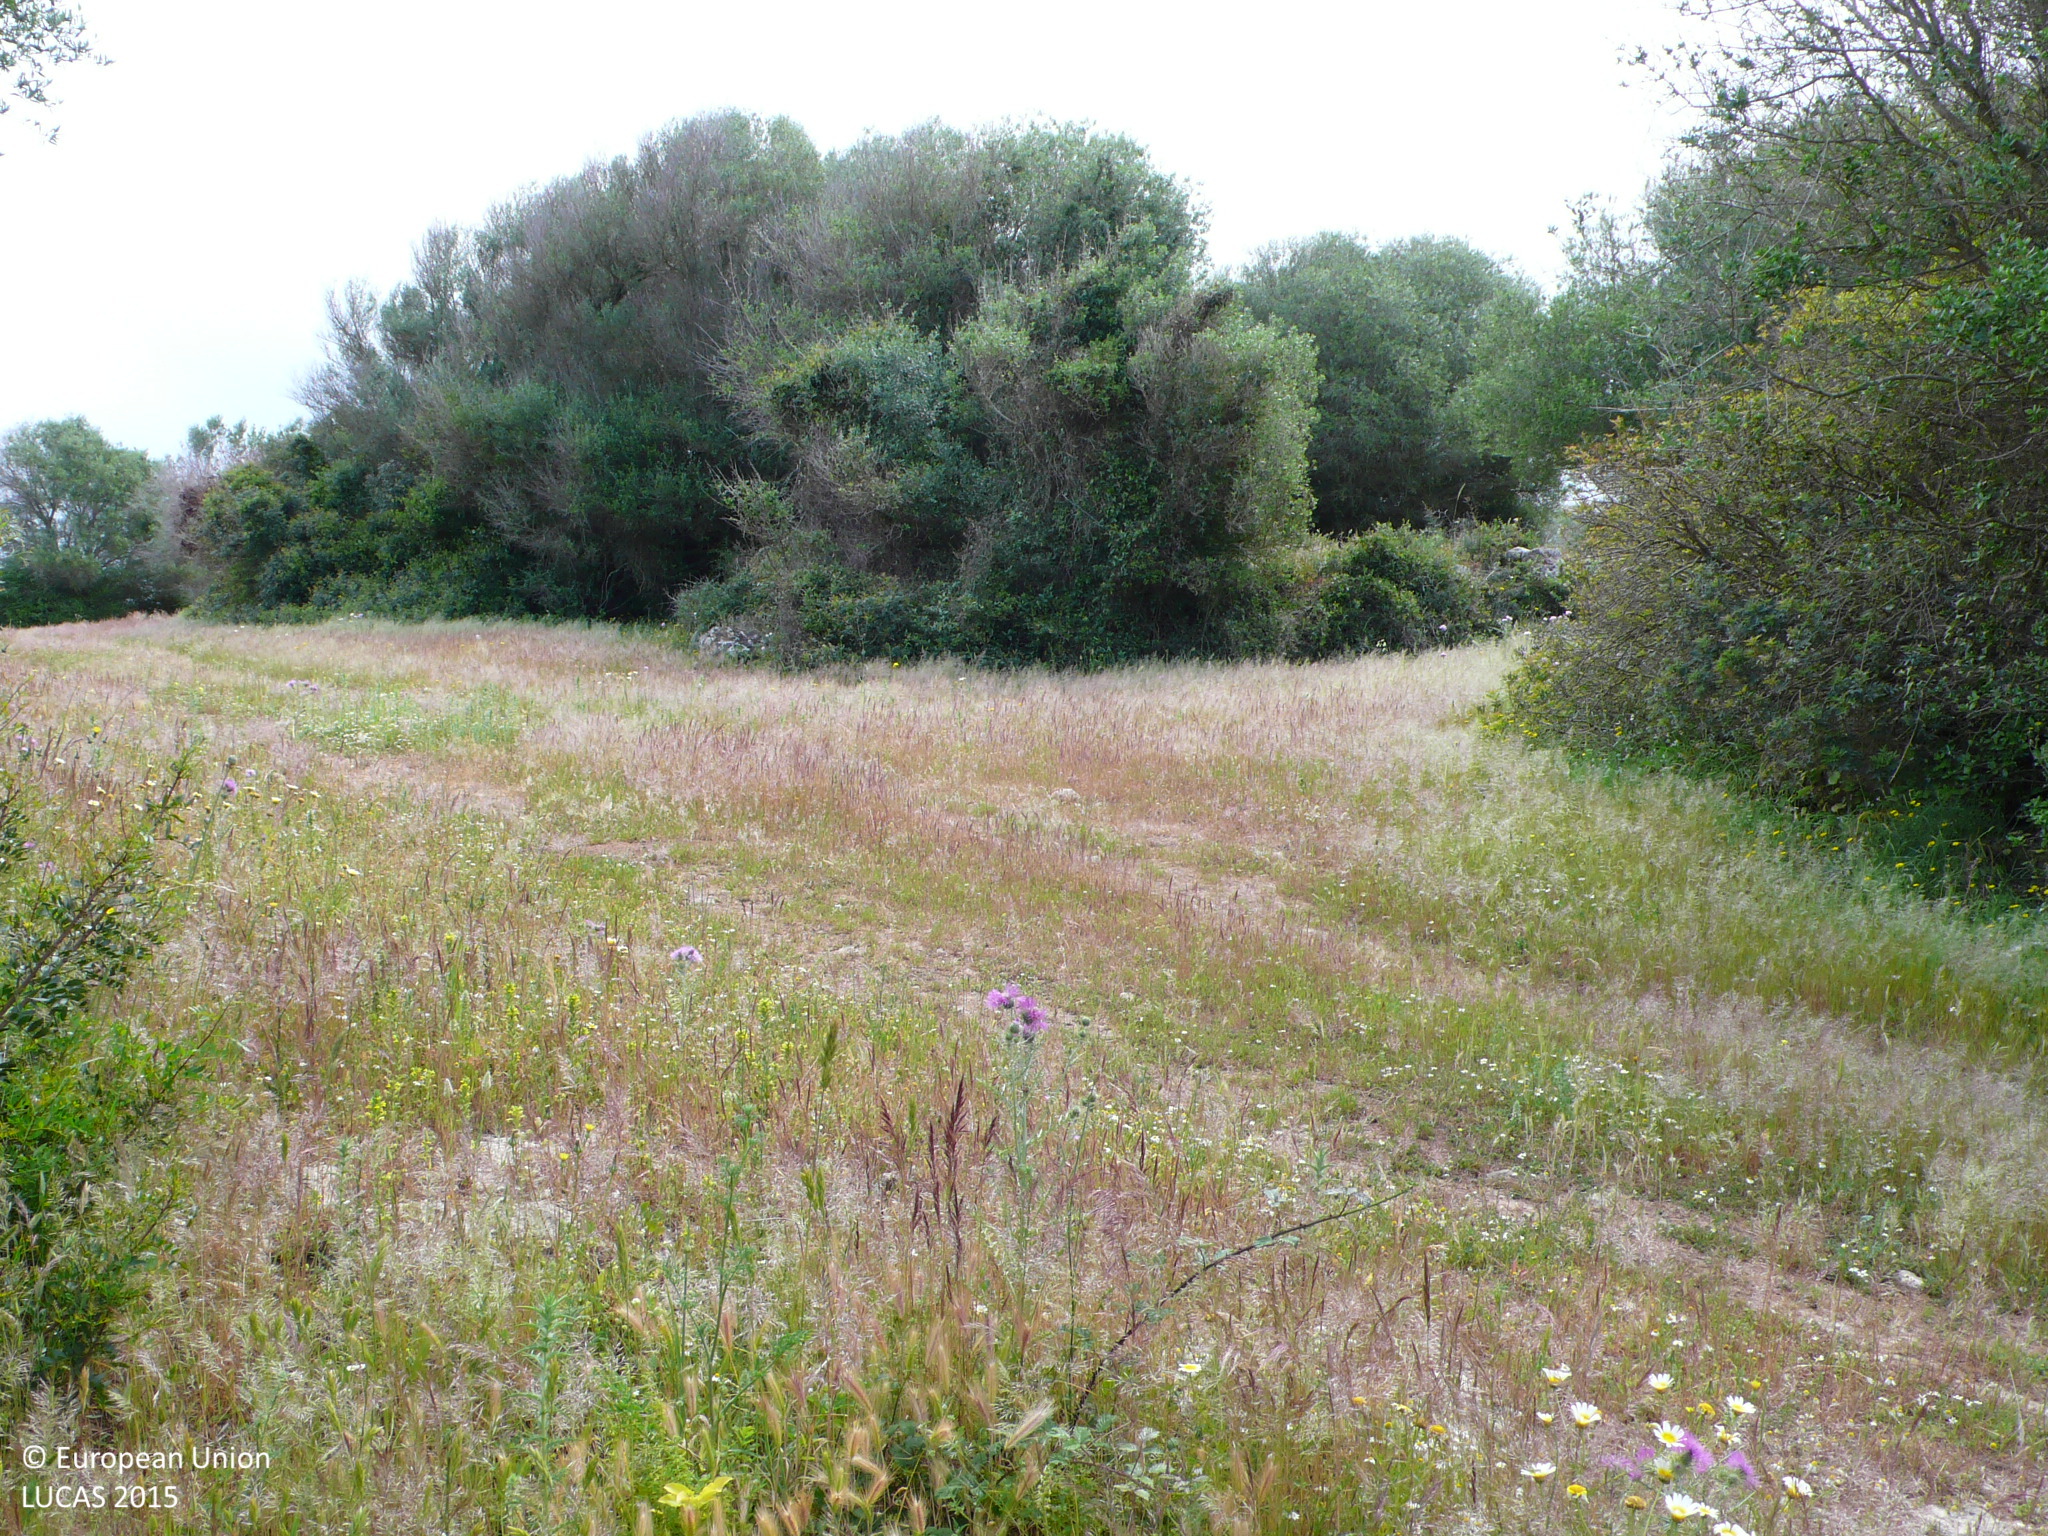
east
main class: Woodland
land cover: Broadleaved woodland
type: broadleaved evergreen forest
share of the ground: 25 - 50 %
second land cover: Grassland without tree/shrub cover
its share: 50 - 75 %
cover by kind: herbaceous plants 50 %, broadleaved forest trees 40 %, shrubs 10 %
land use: Forestry
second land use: Agriculture (excluding fallow land and kitchen gardens)
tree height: > 5 m
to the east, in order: Broadleaved woodland; Grassland without tree/shrub cover; Dry stone walls; Mixed cereals for fodder; Broadleaved woodland; Dry stone walls; Tracks; Dry stone walls; Broadleaved woodland
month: May
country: ES
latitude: 39.9593
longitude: 4.0442
